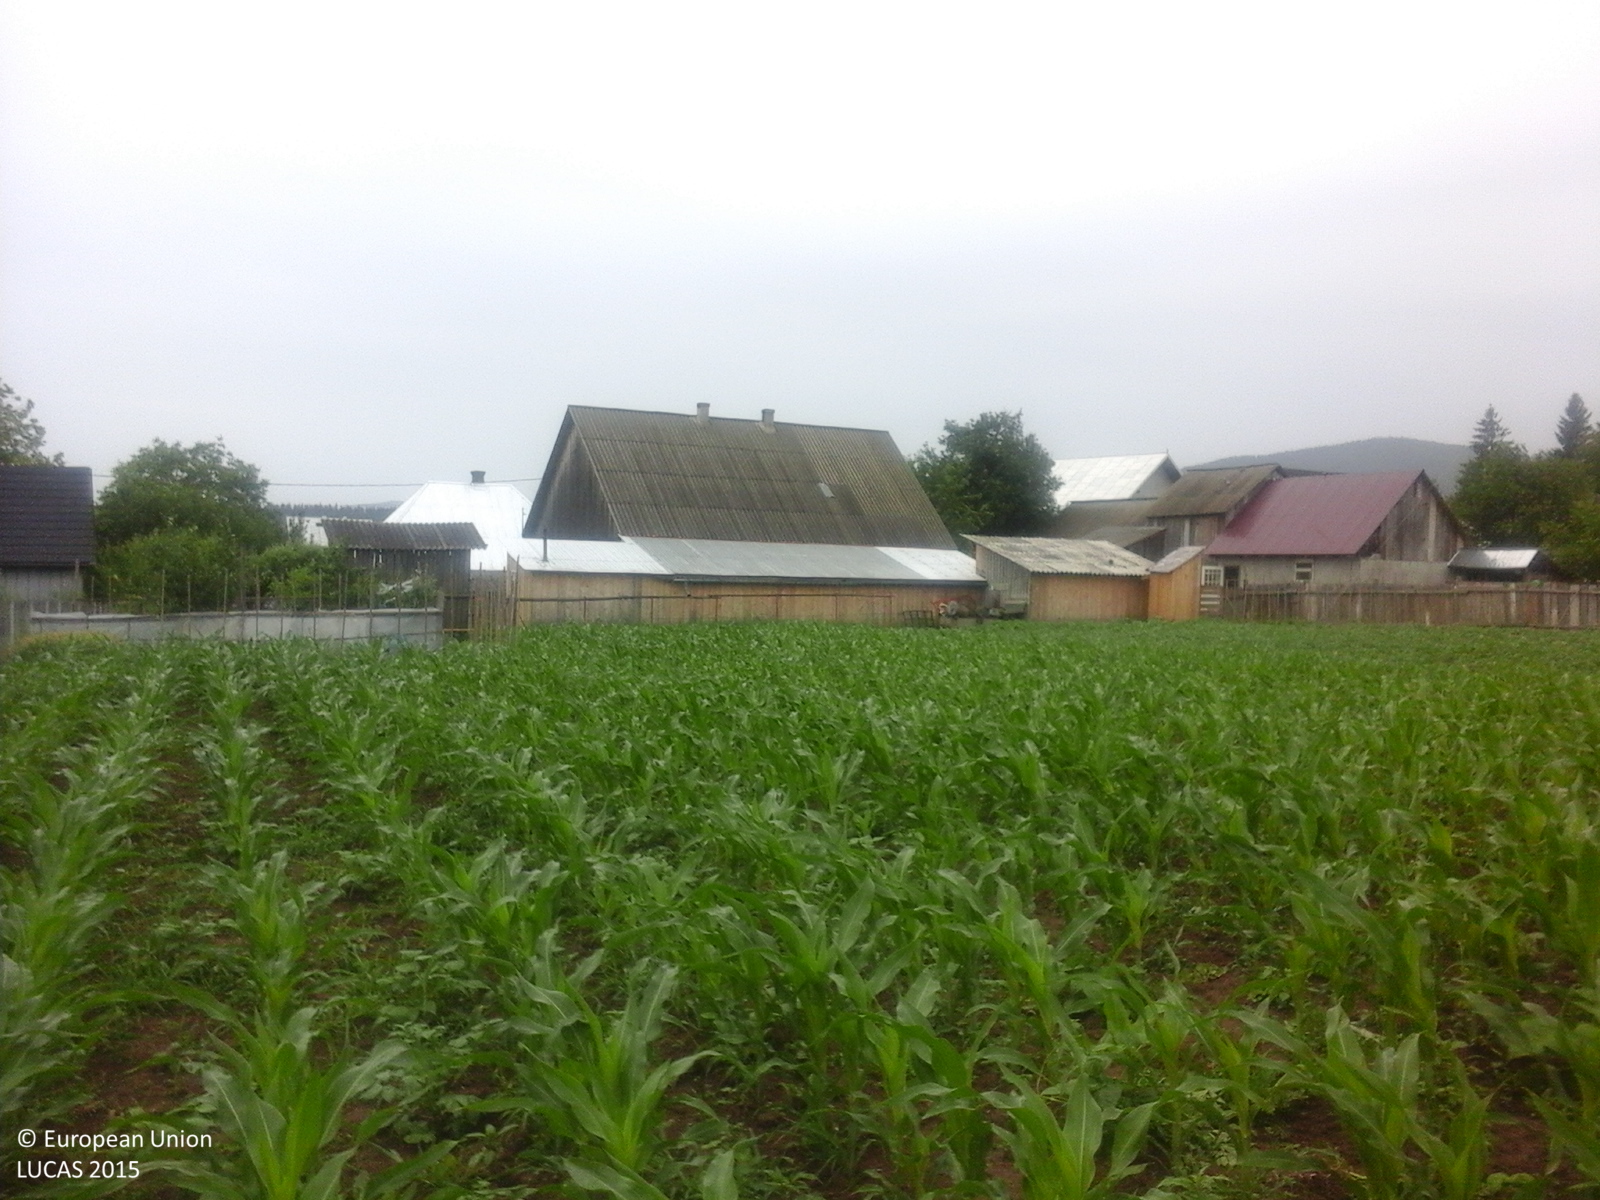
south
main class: Cropland
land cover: Maize
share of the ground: 25 - 50 %
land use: Agriculture (excluding fallow land and kitchen gardens)
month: June
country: RO
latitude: 47.8949
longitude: 25.7064
